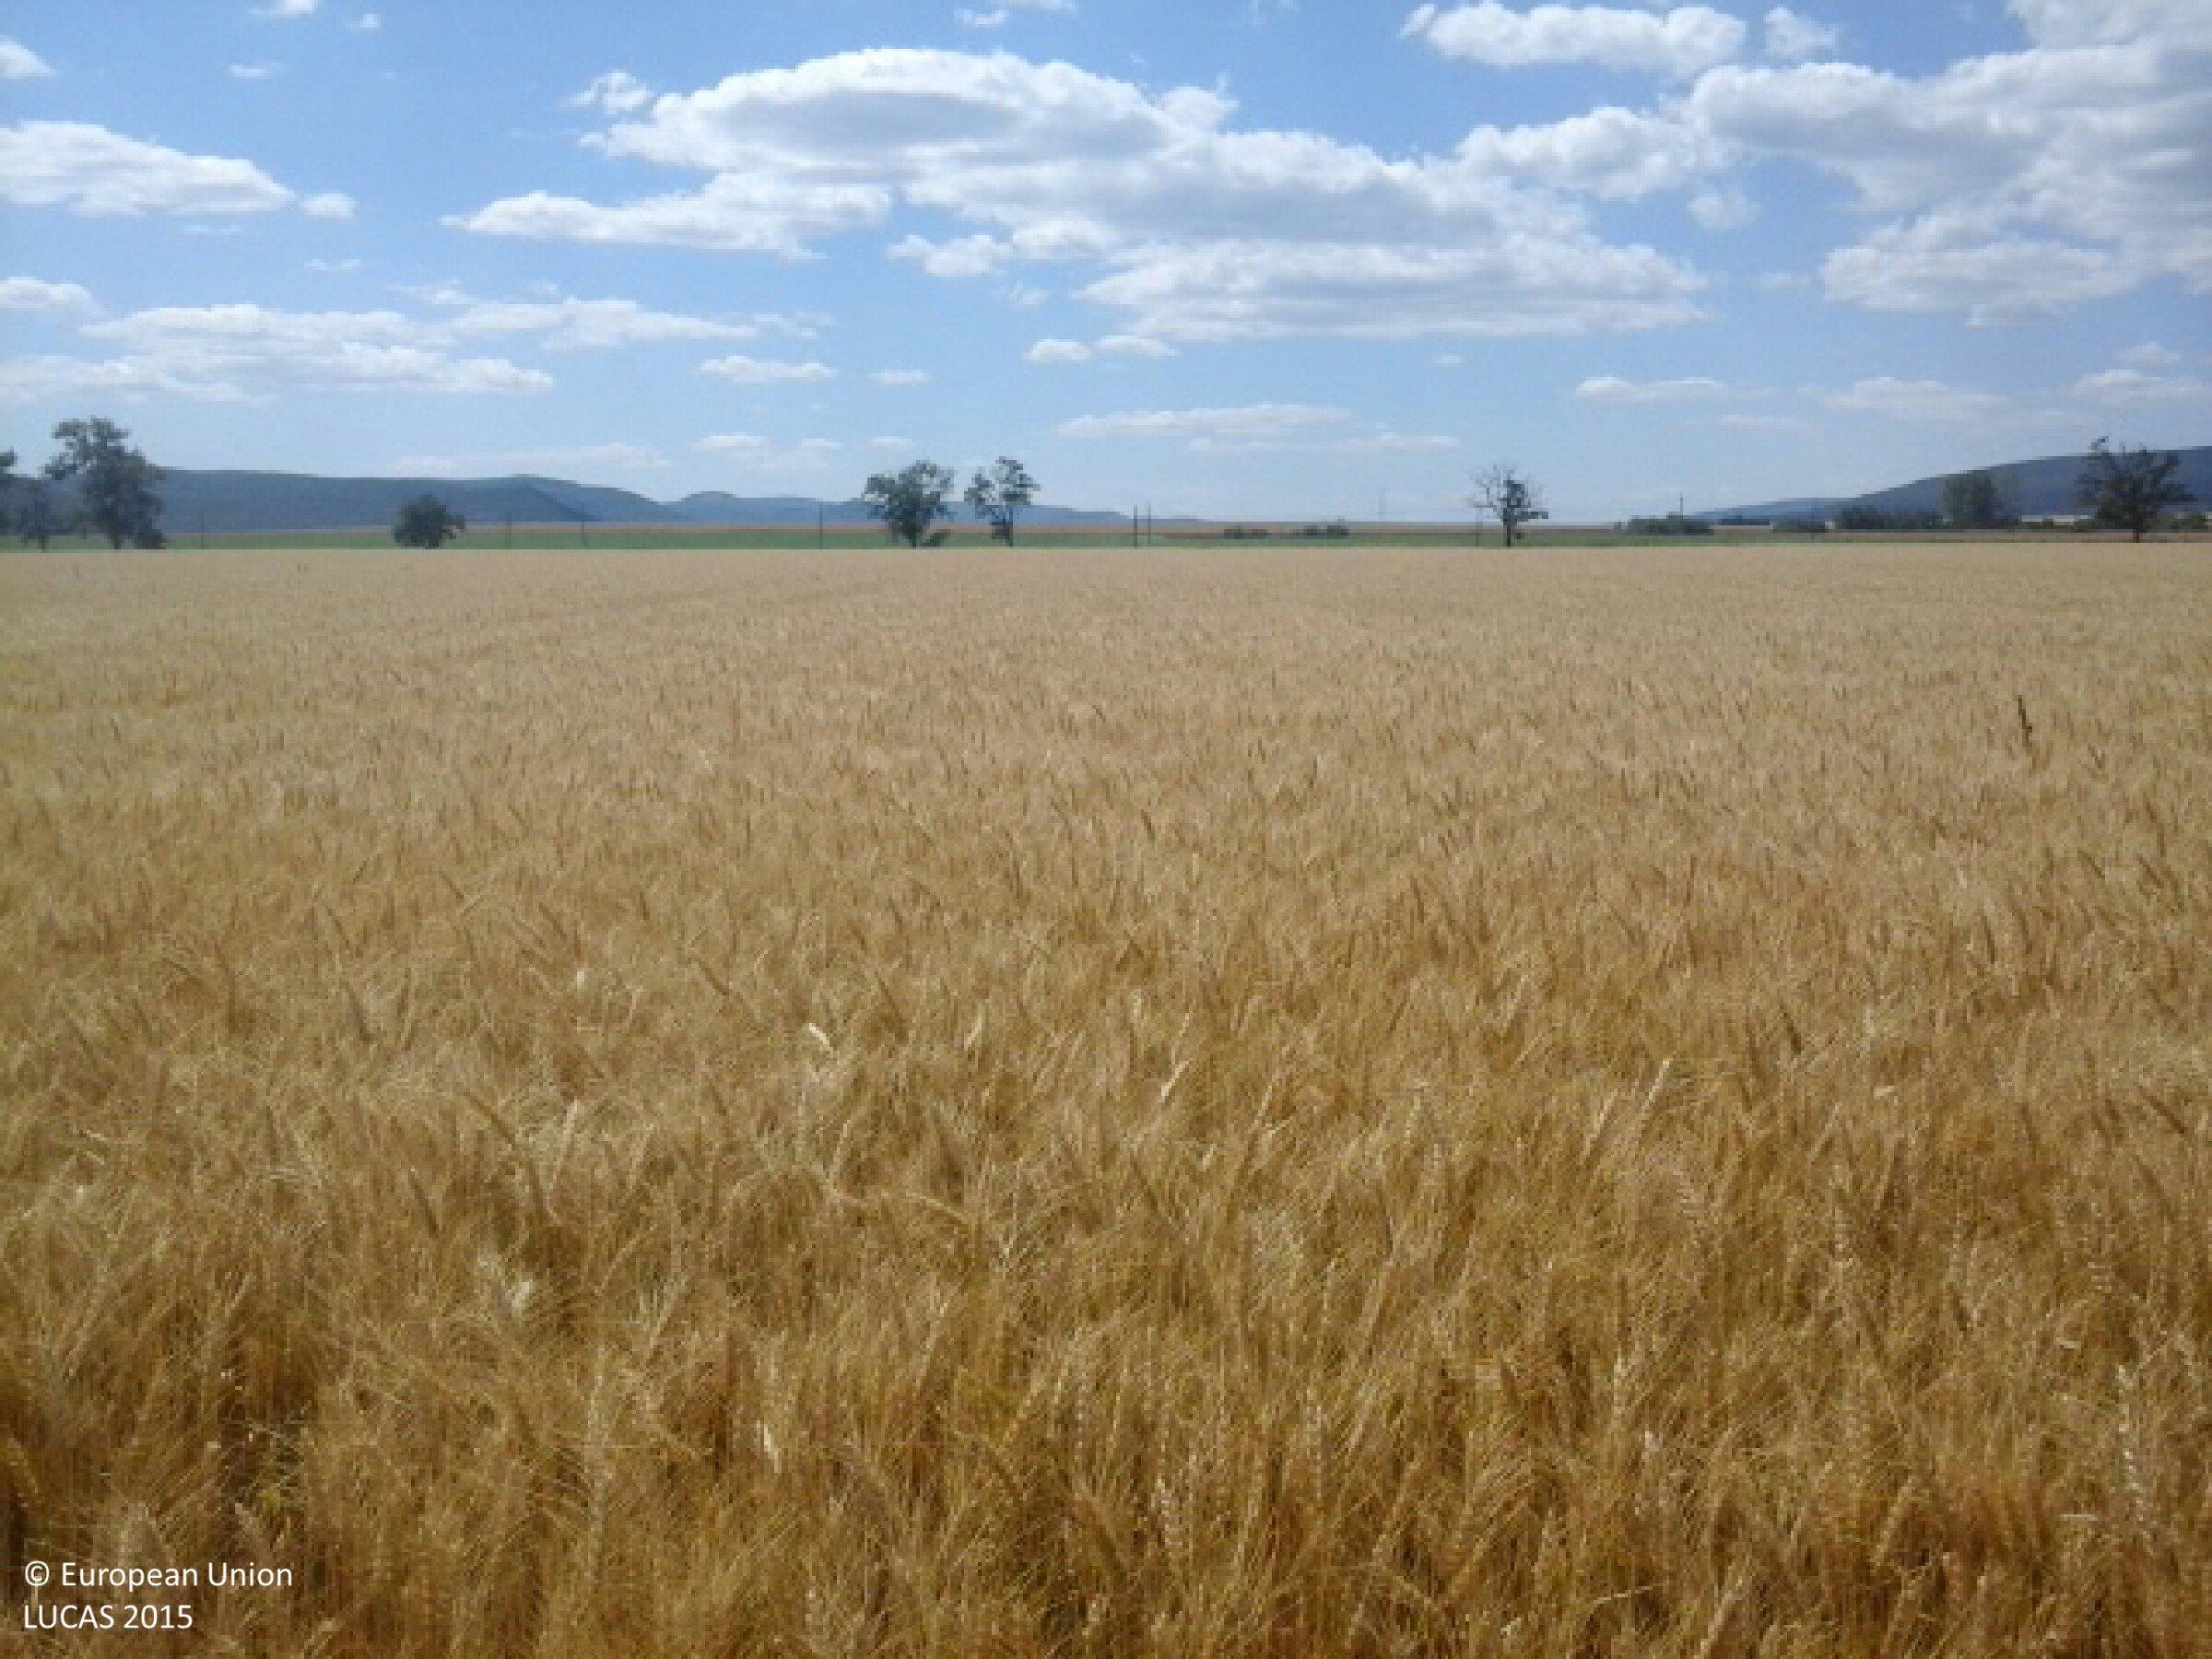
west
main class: Cropland
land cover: Triticale
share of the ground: > 75 %
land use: Agriculture (excluding fallow land and kitchen gardens)
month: July
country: HU
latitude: 48.4797
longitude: 21.6152
